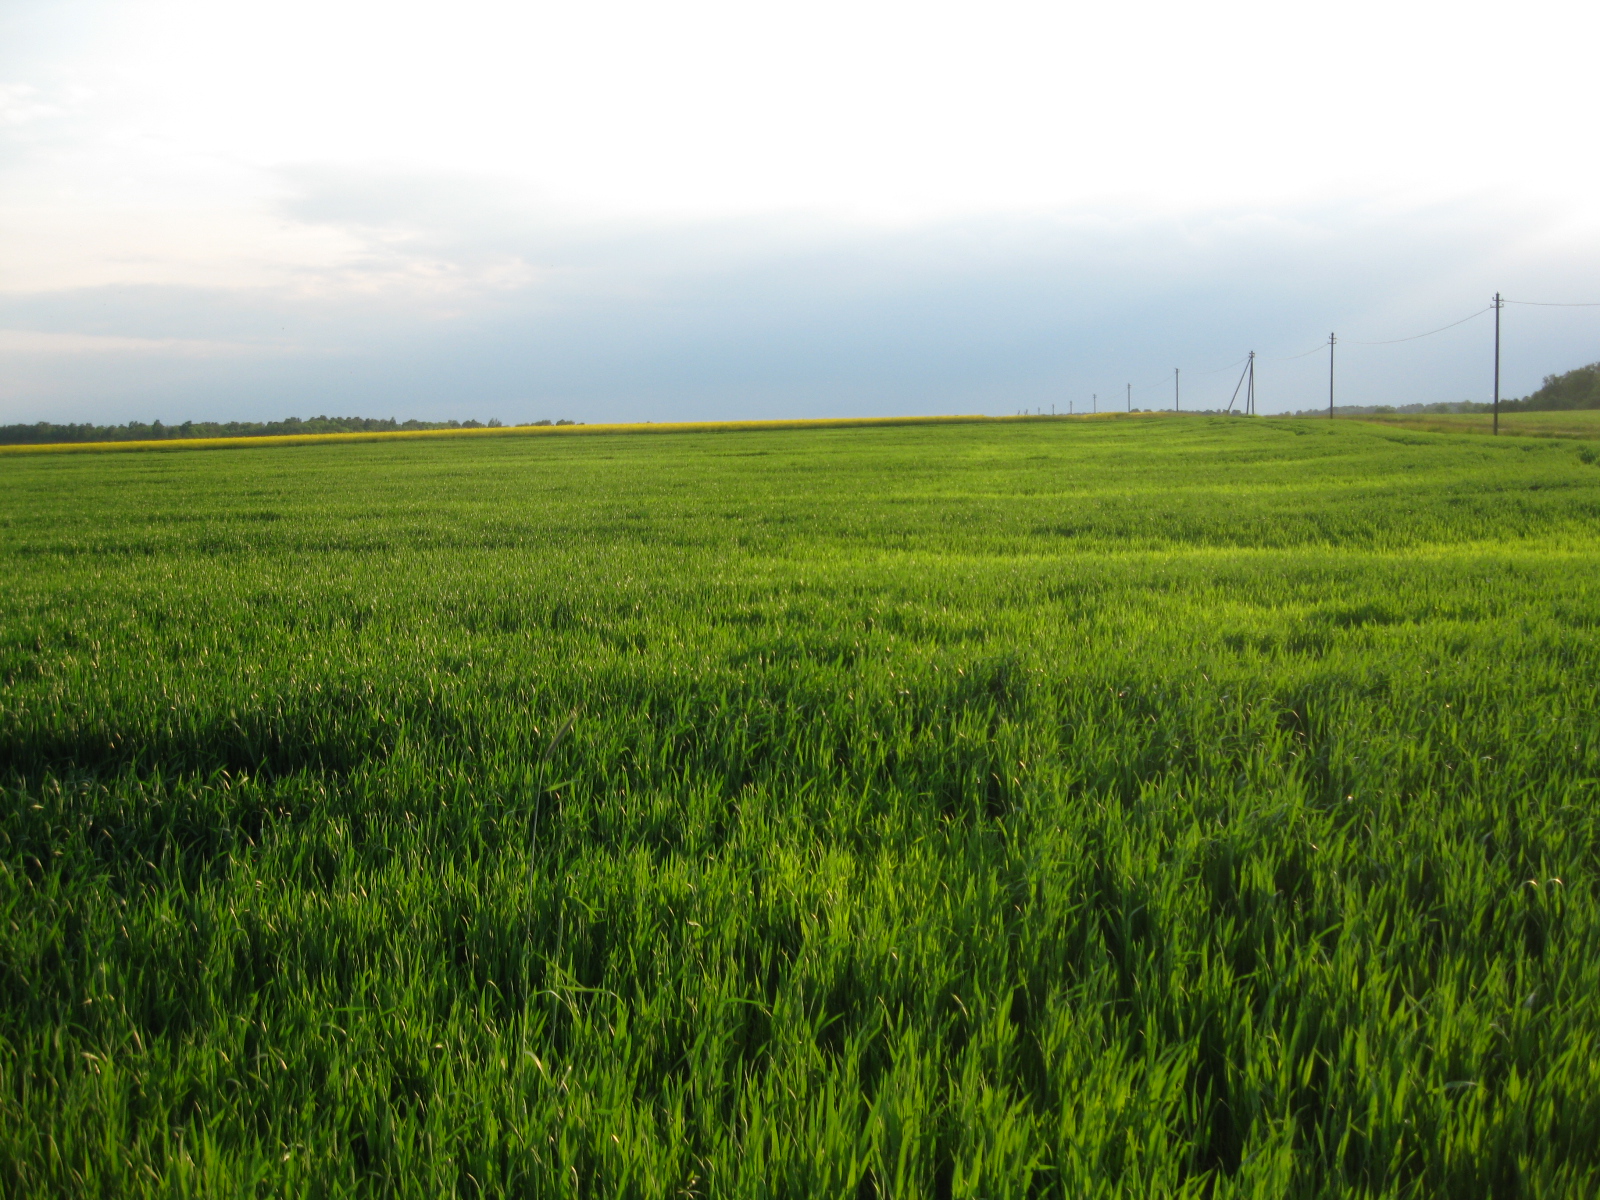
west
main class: Cropland
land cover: Common wheat
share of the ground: > 75 %
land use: Agriculture (excluding fallow land and kitchen gardens)
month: June
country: LT
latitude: 55.8466
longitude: 24.0642
